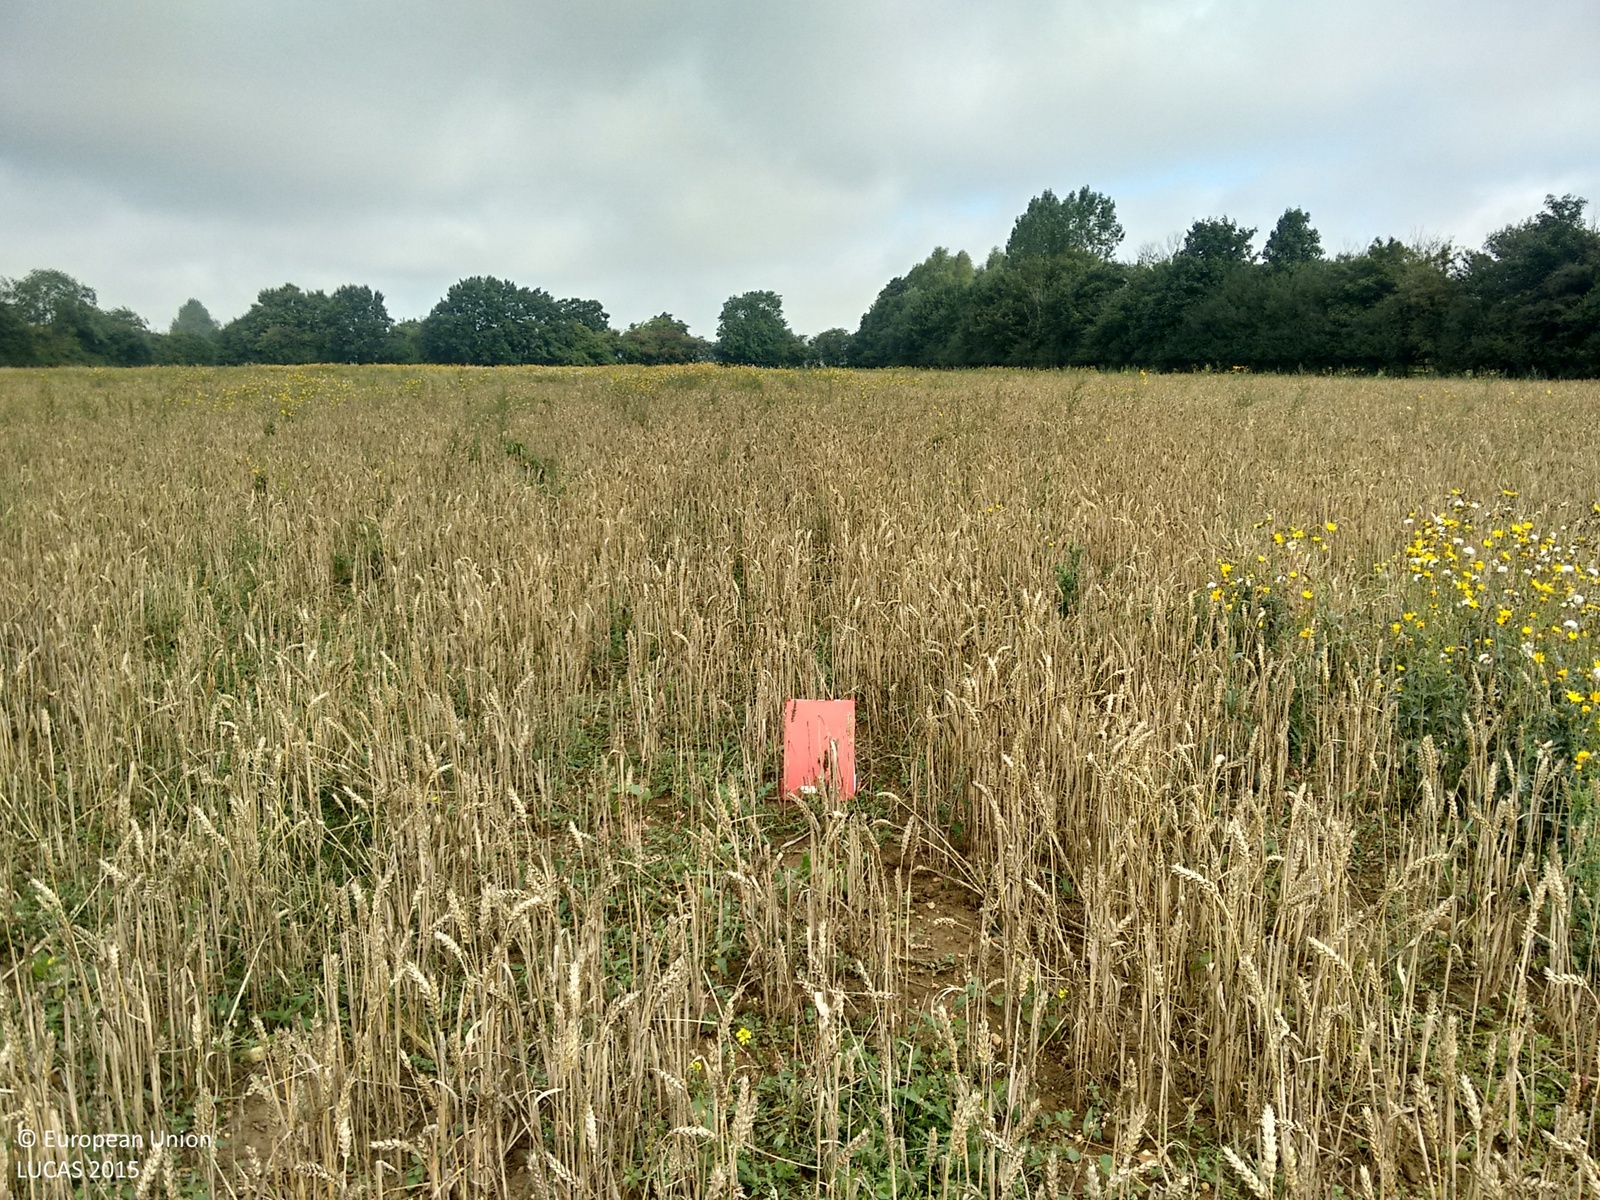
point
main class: Cropland
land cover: Common wheat
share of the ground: > 75 %
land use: Agriculture (excluding fallow land and kitchen gardens)
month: September
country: GB
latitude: 52.2001
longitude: 0.5650
